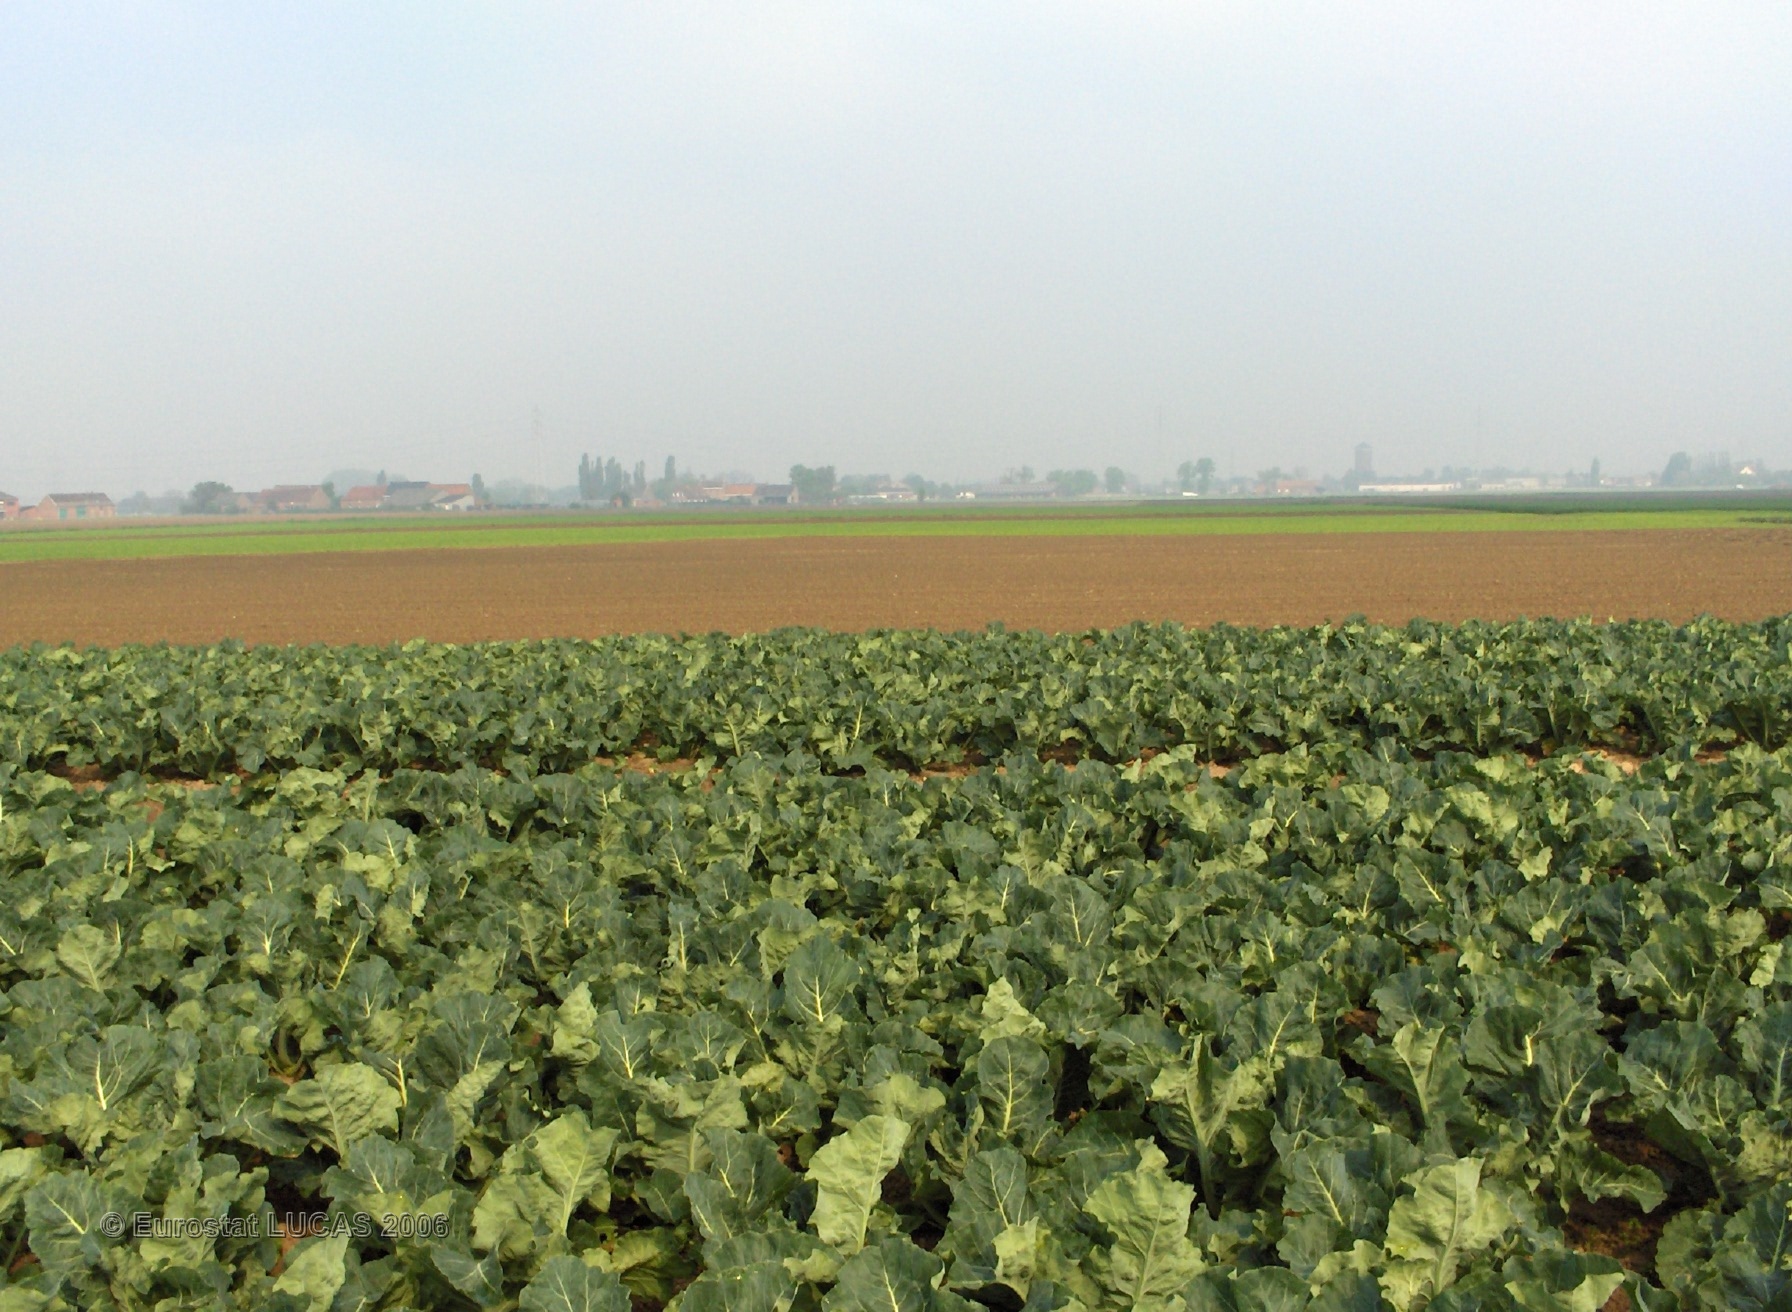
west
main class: Cropland
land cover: Other fresh vegetables
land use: Agriculture (excluding fallow land and kitchen gardens)
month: May
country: BE
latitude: 51.0210
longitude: 4.4214
